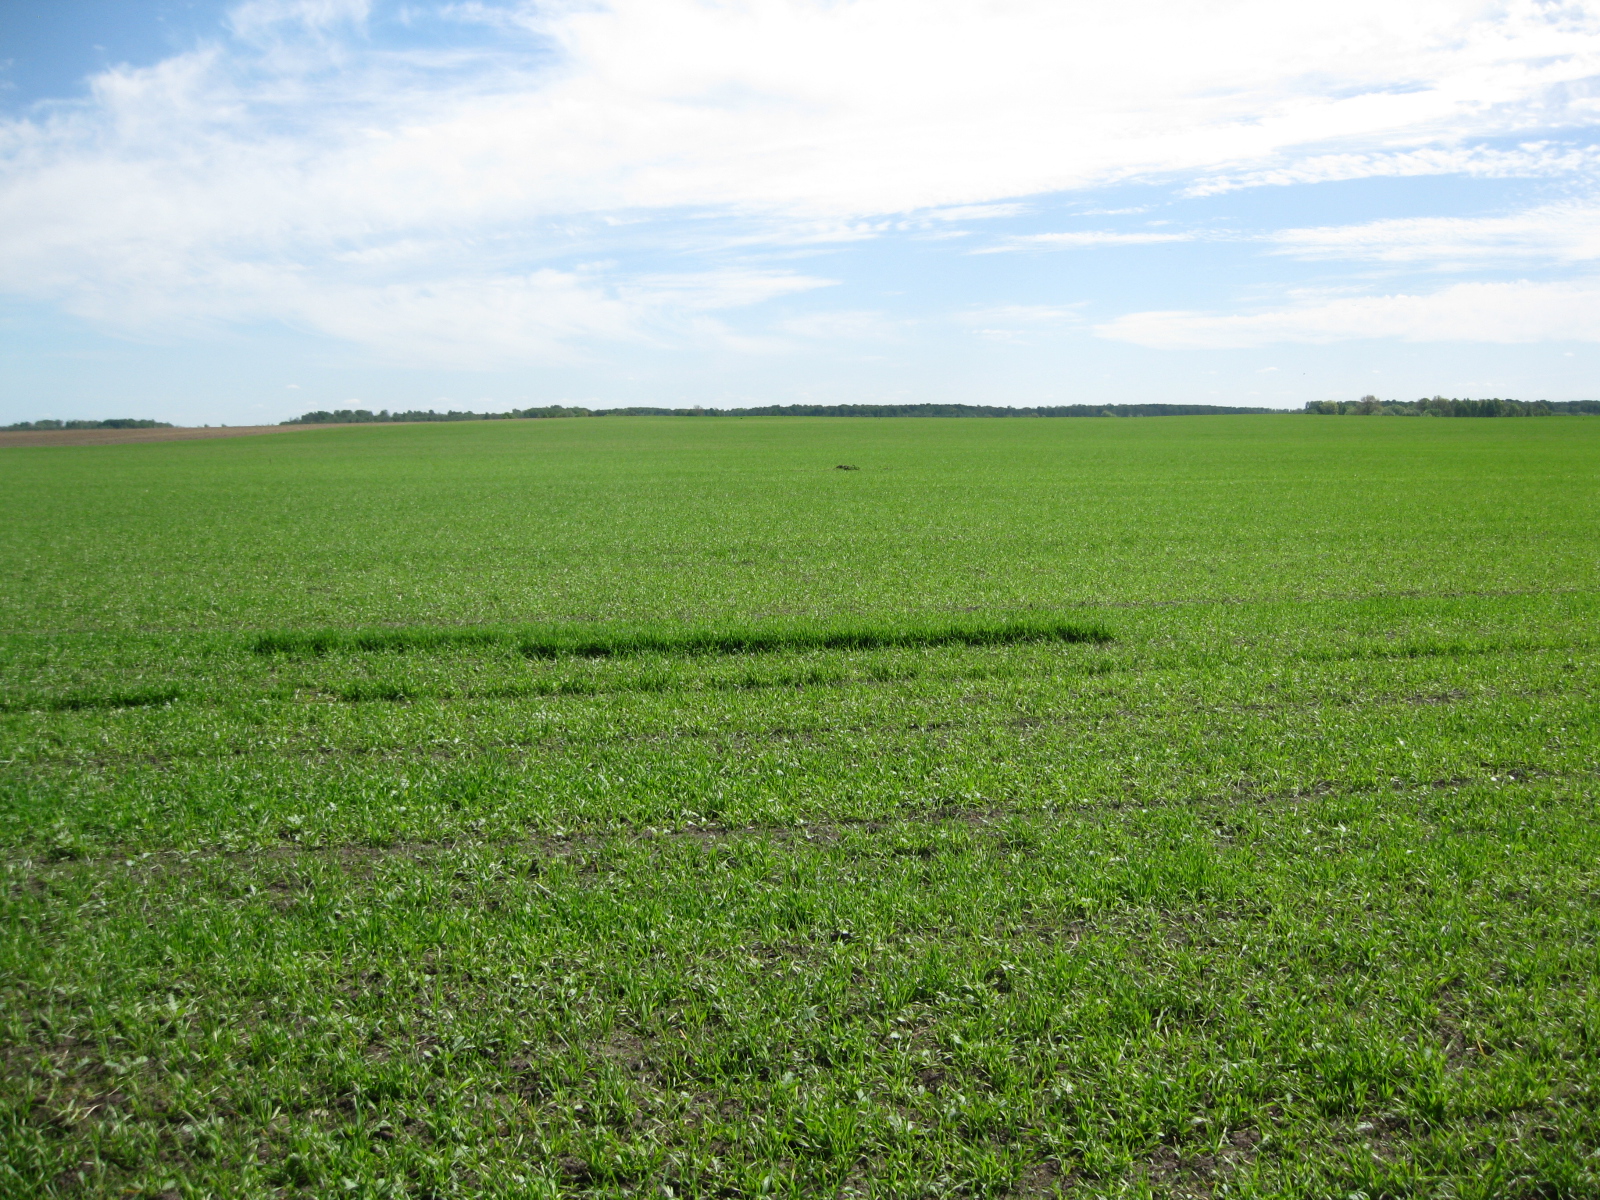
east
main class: Cropland
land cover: Barley
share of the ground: > 75 %
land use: Agriculture (excluding fallow land and kitchen gardens)
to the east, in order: Barley; Maize
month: May
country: LT
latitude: 56.1488
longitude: 24.1421
